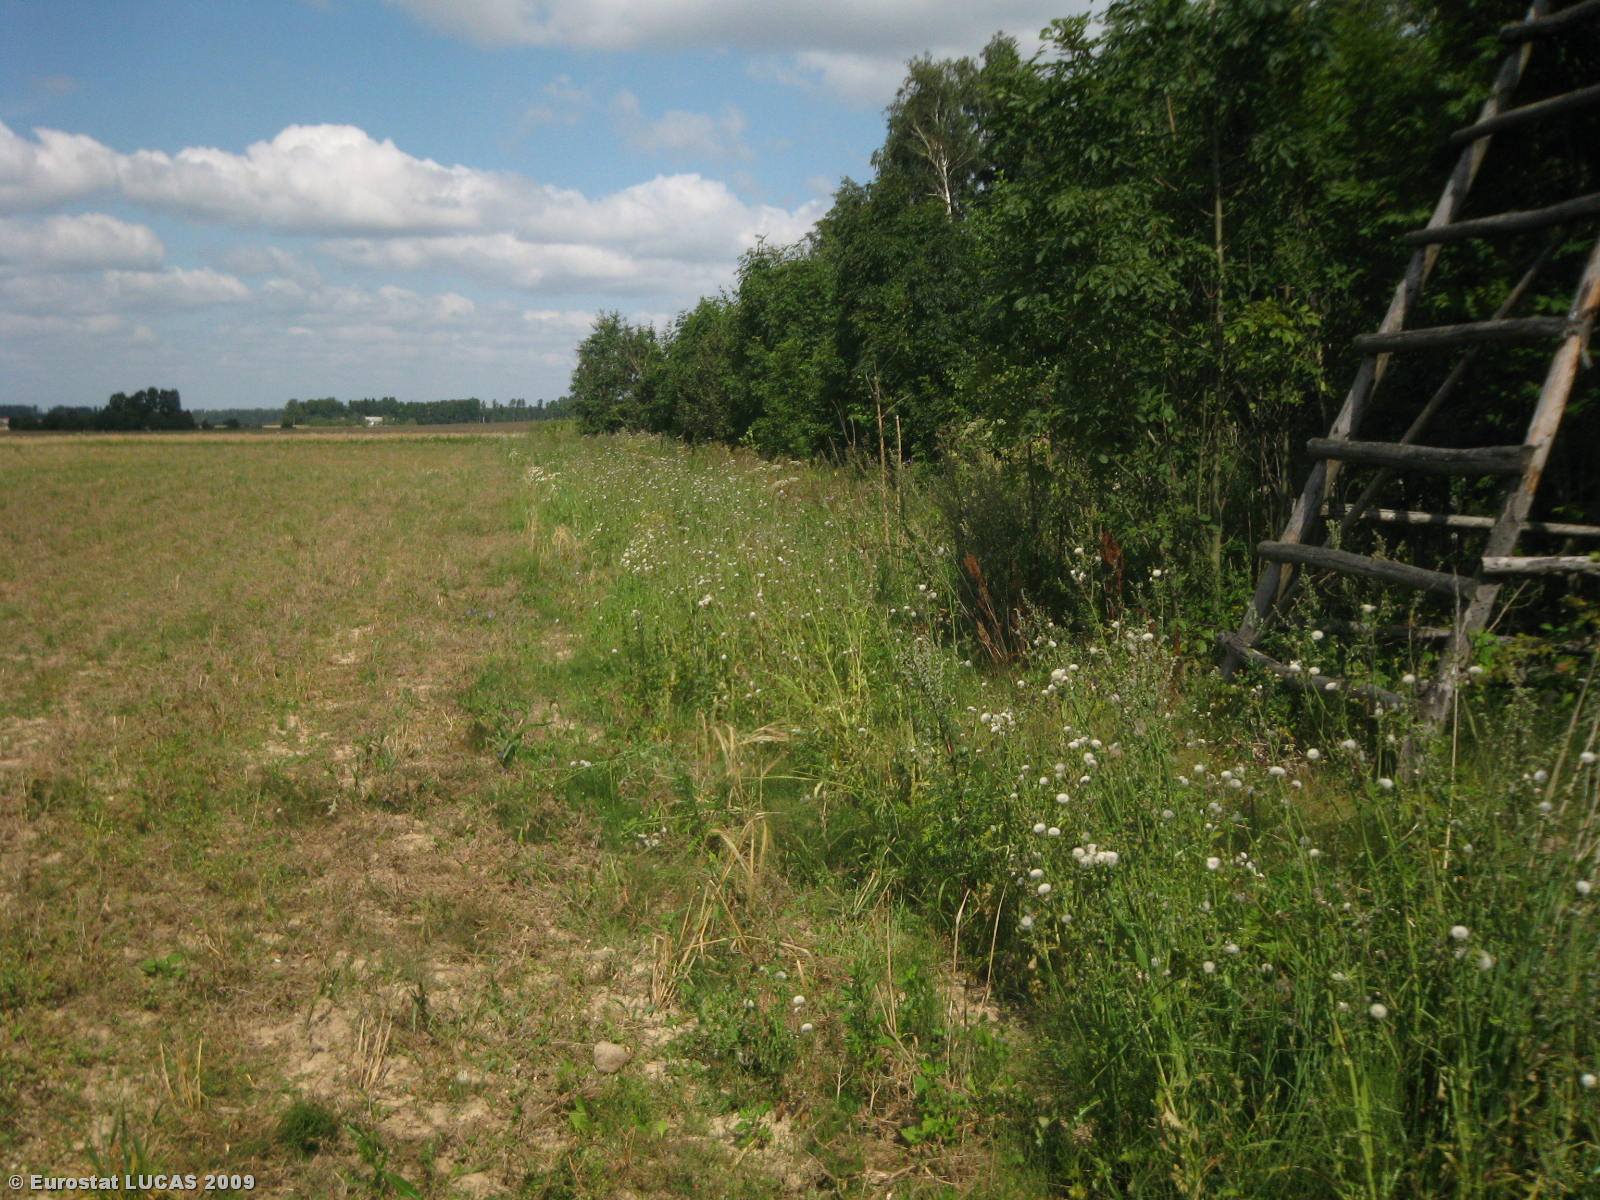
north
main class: Grassland
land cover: Spontaneously vegetated surfaces
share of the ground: > 75 %
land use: Fallow land
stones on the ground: < 10 %
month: August
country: LT
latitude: 55.1780
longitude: 23.6662
